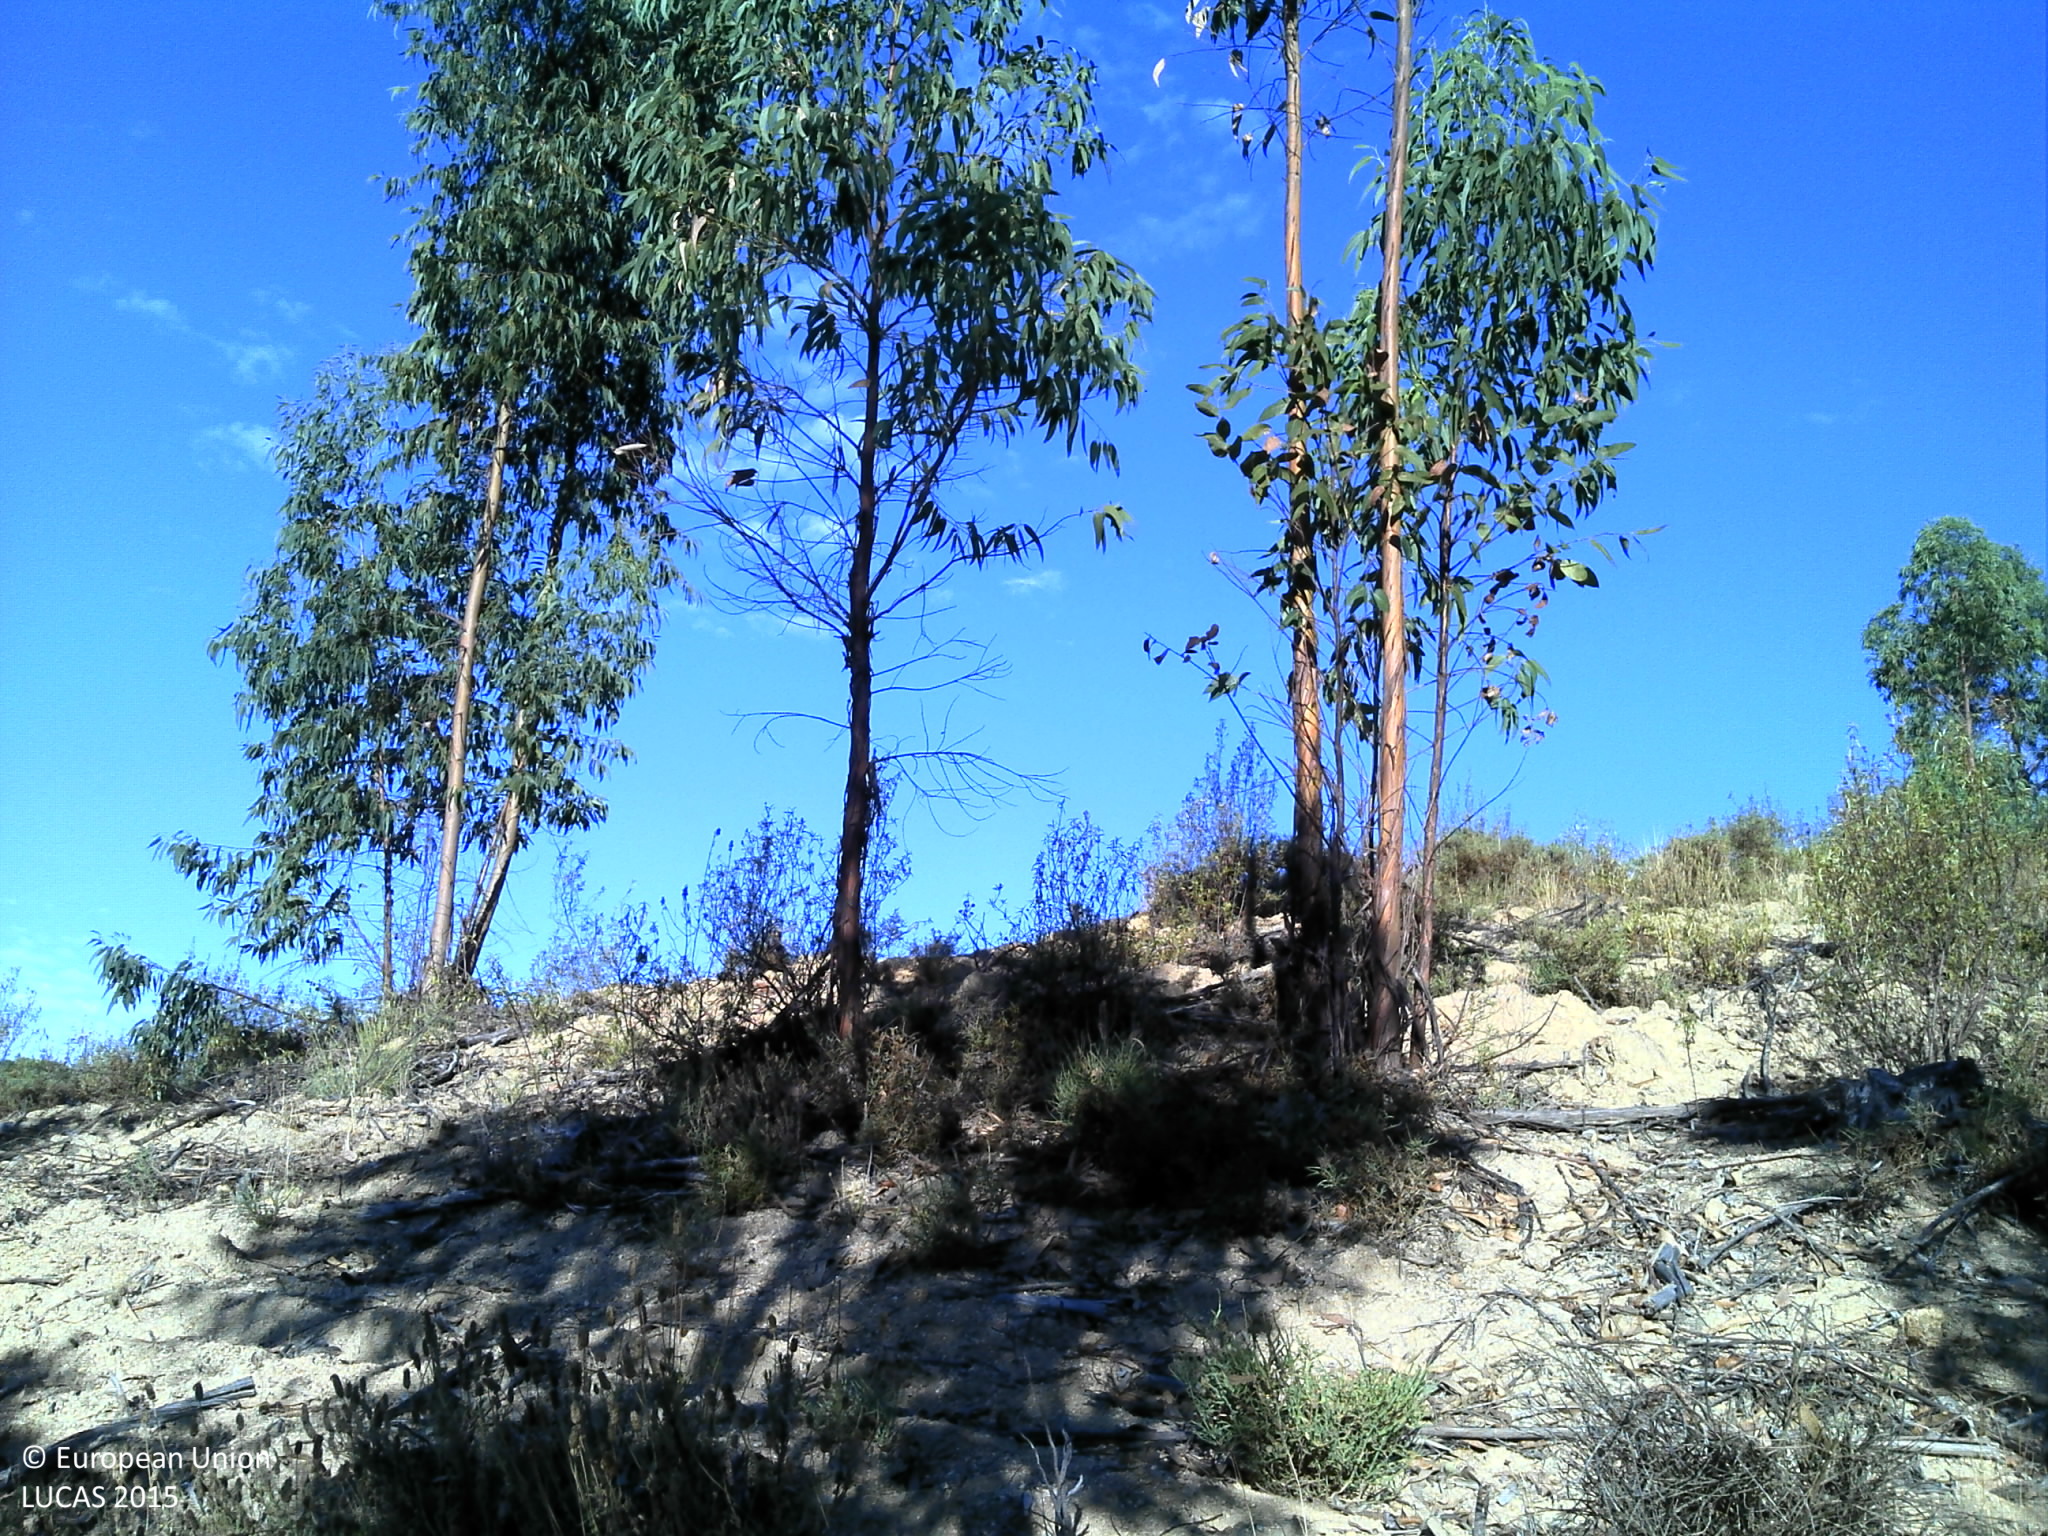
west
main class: Woodland
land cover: Broadleaved woodland
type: broadleaved evergreen forest
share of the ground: 10 - 25 %
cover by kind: unconsolidated bare surface 75 %, broadleaved forest trees 10 %, herbaceous plants 10 %, shrubs 5 %
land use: Forestry
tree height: > 5 m
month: August
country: PT
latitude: 39.5173
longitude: -7.7690
